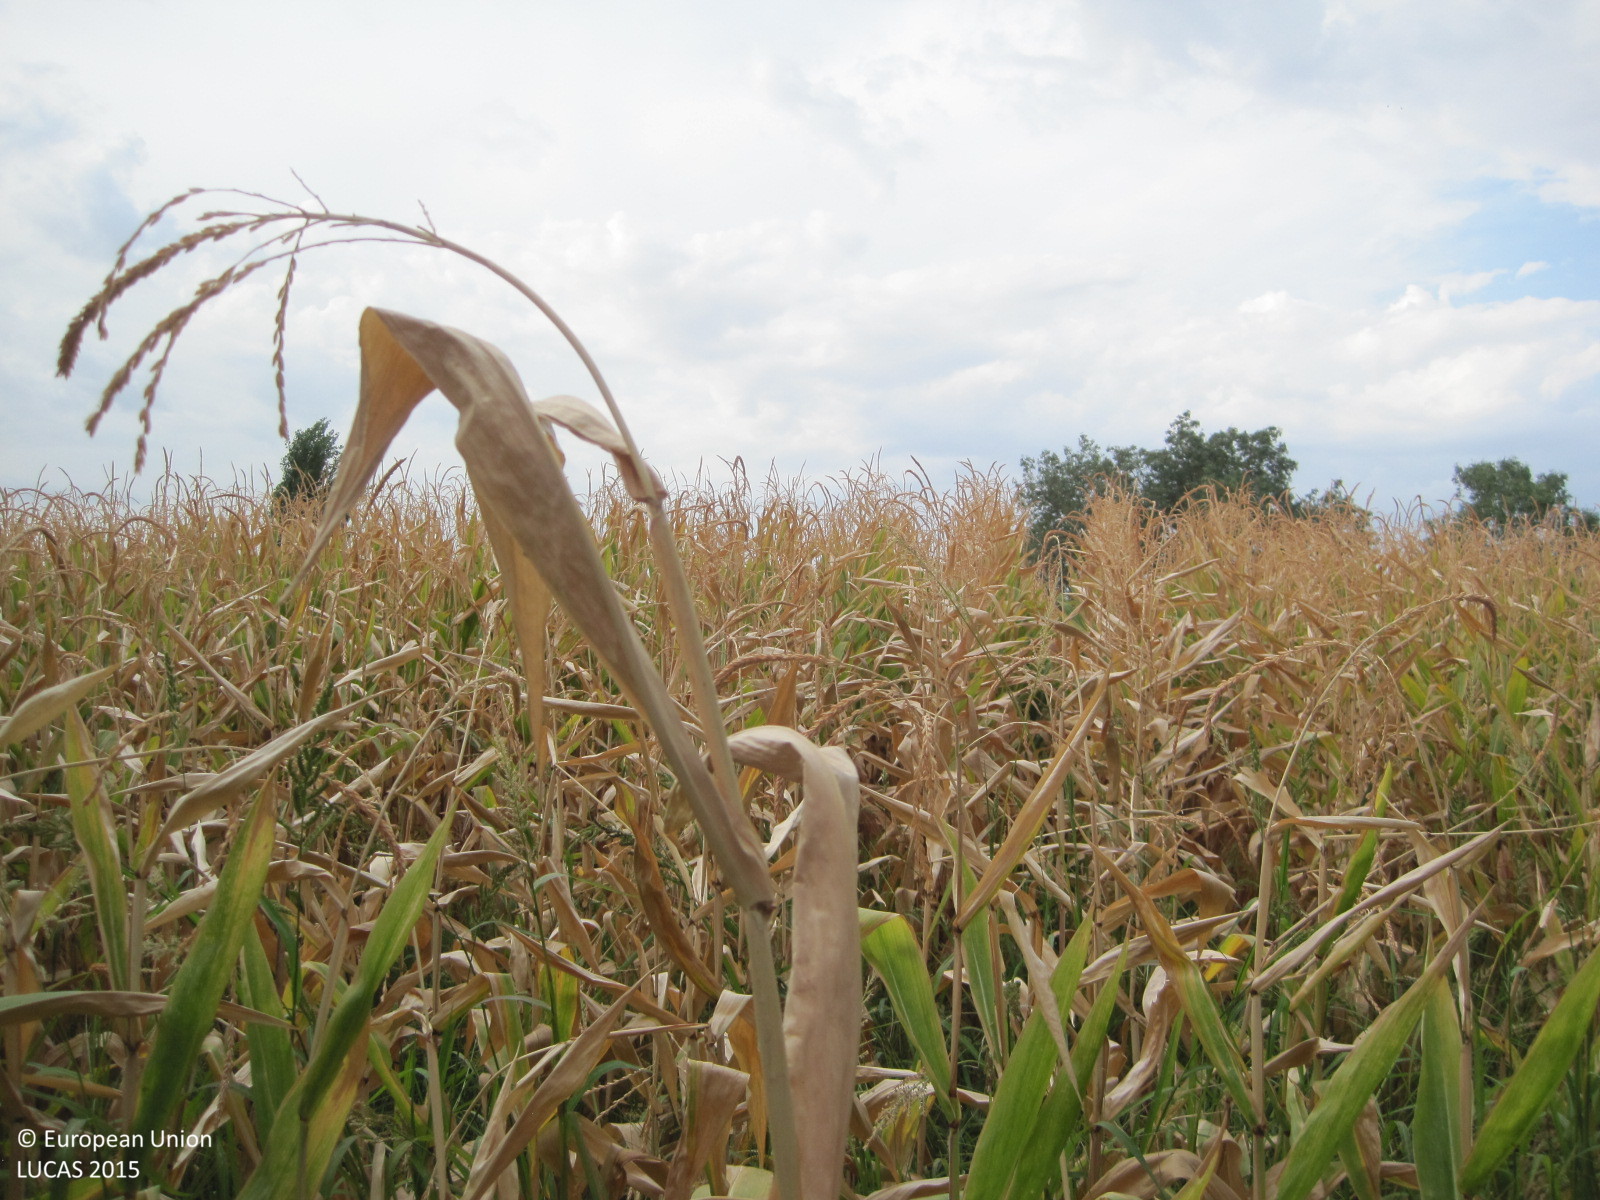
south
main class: Cropland
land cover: Maize
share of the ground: > 75 %
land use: Agriculture (excluding fallow land and kitchen gardens)
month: August
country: ES
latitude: 39.8847
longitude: -4.9581
